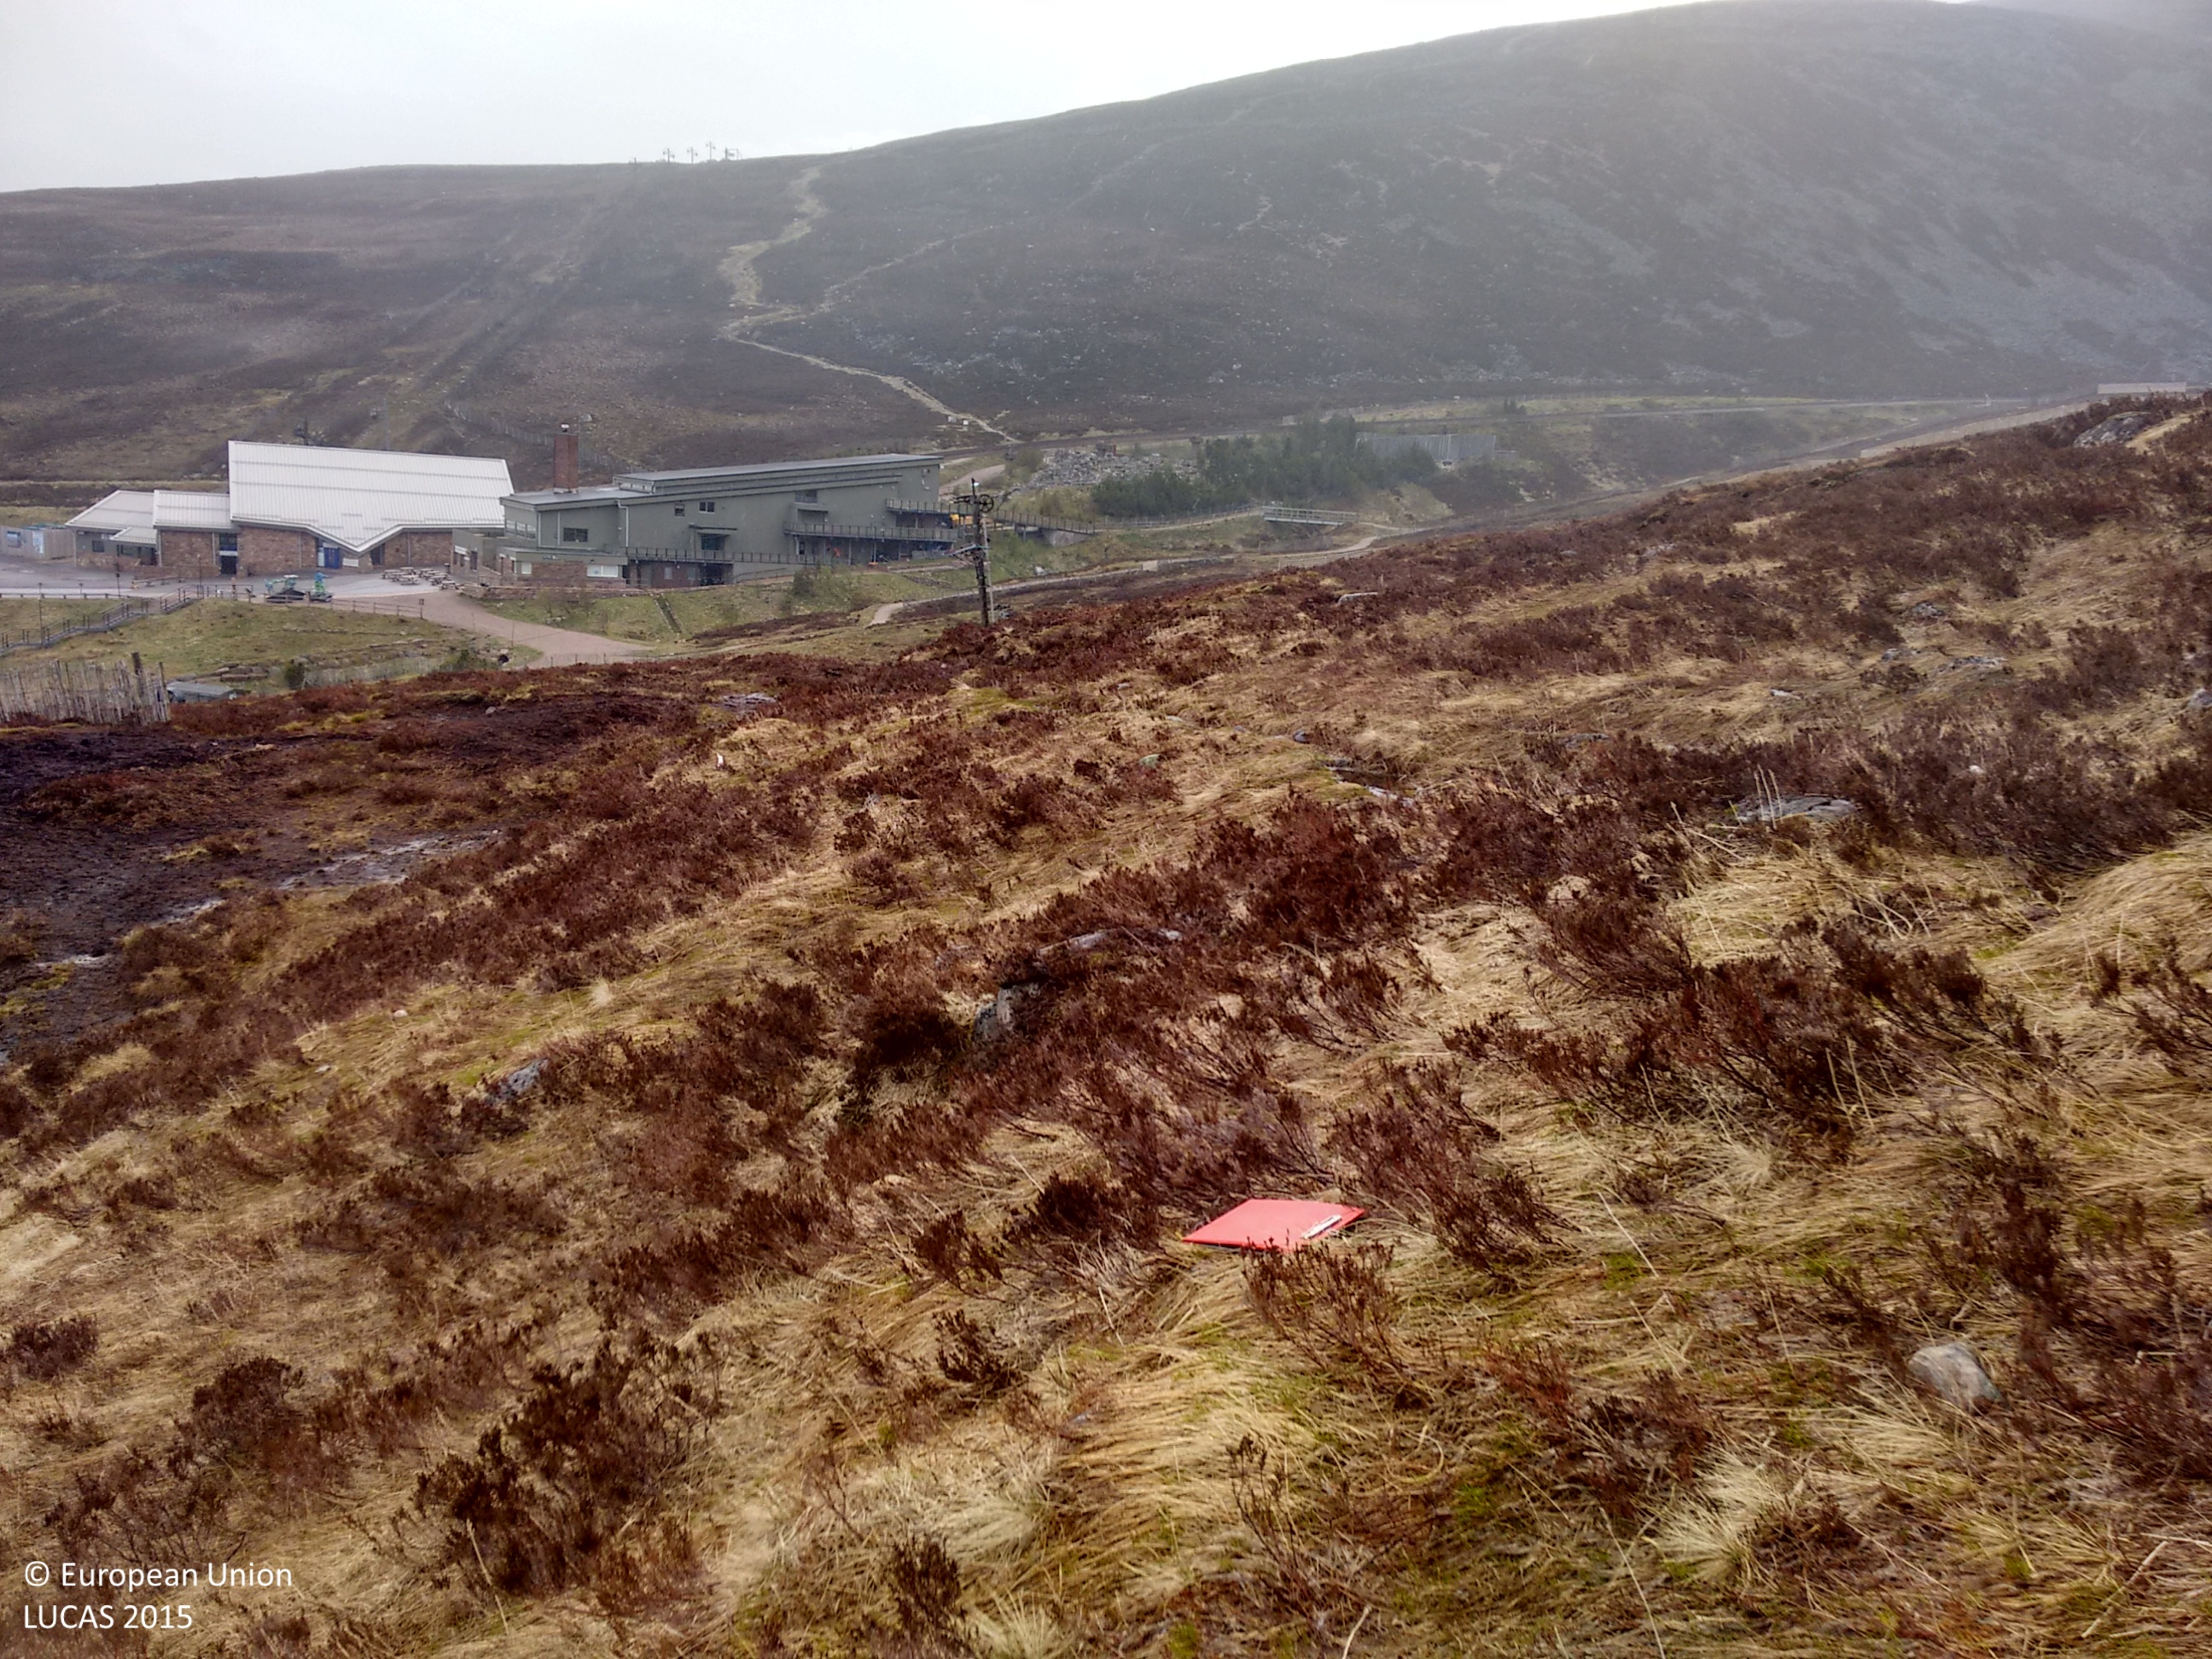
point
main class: Shrubland
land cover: Shrubland without tree cover
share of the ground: > 75 %
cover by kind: shrubs 55 %, herbaceous plants 40 %, unconsolidated bare surface 5 %
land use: Sport
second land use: Amenities, museums, leisure
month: June
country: GB
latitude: 57.1323
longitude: -3.6726
